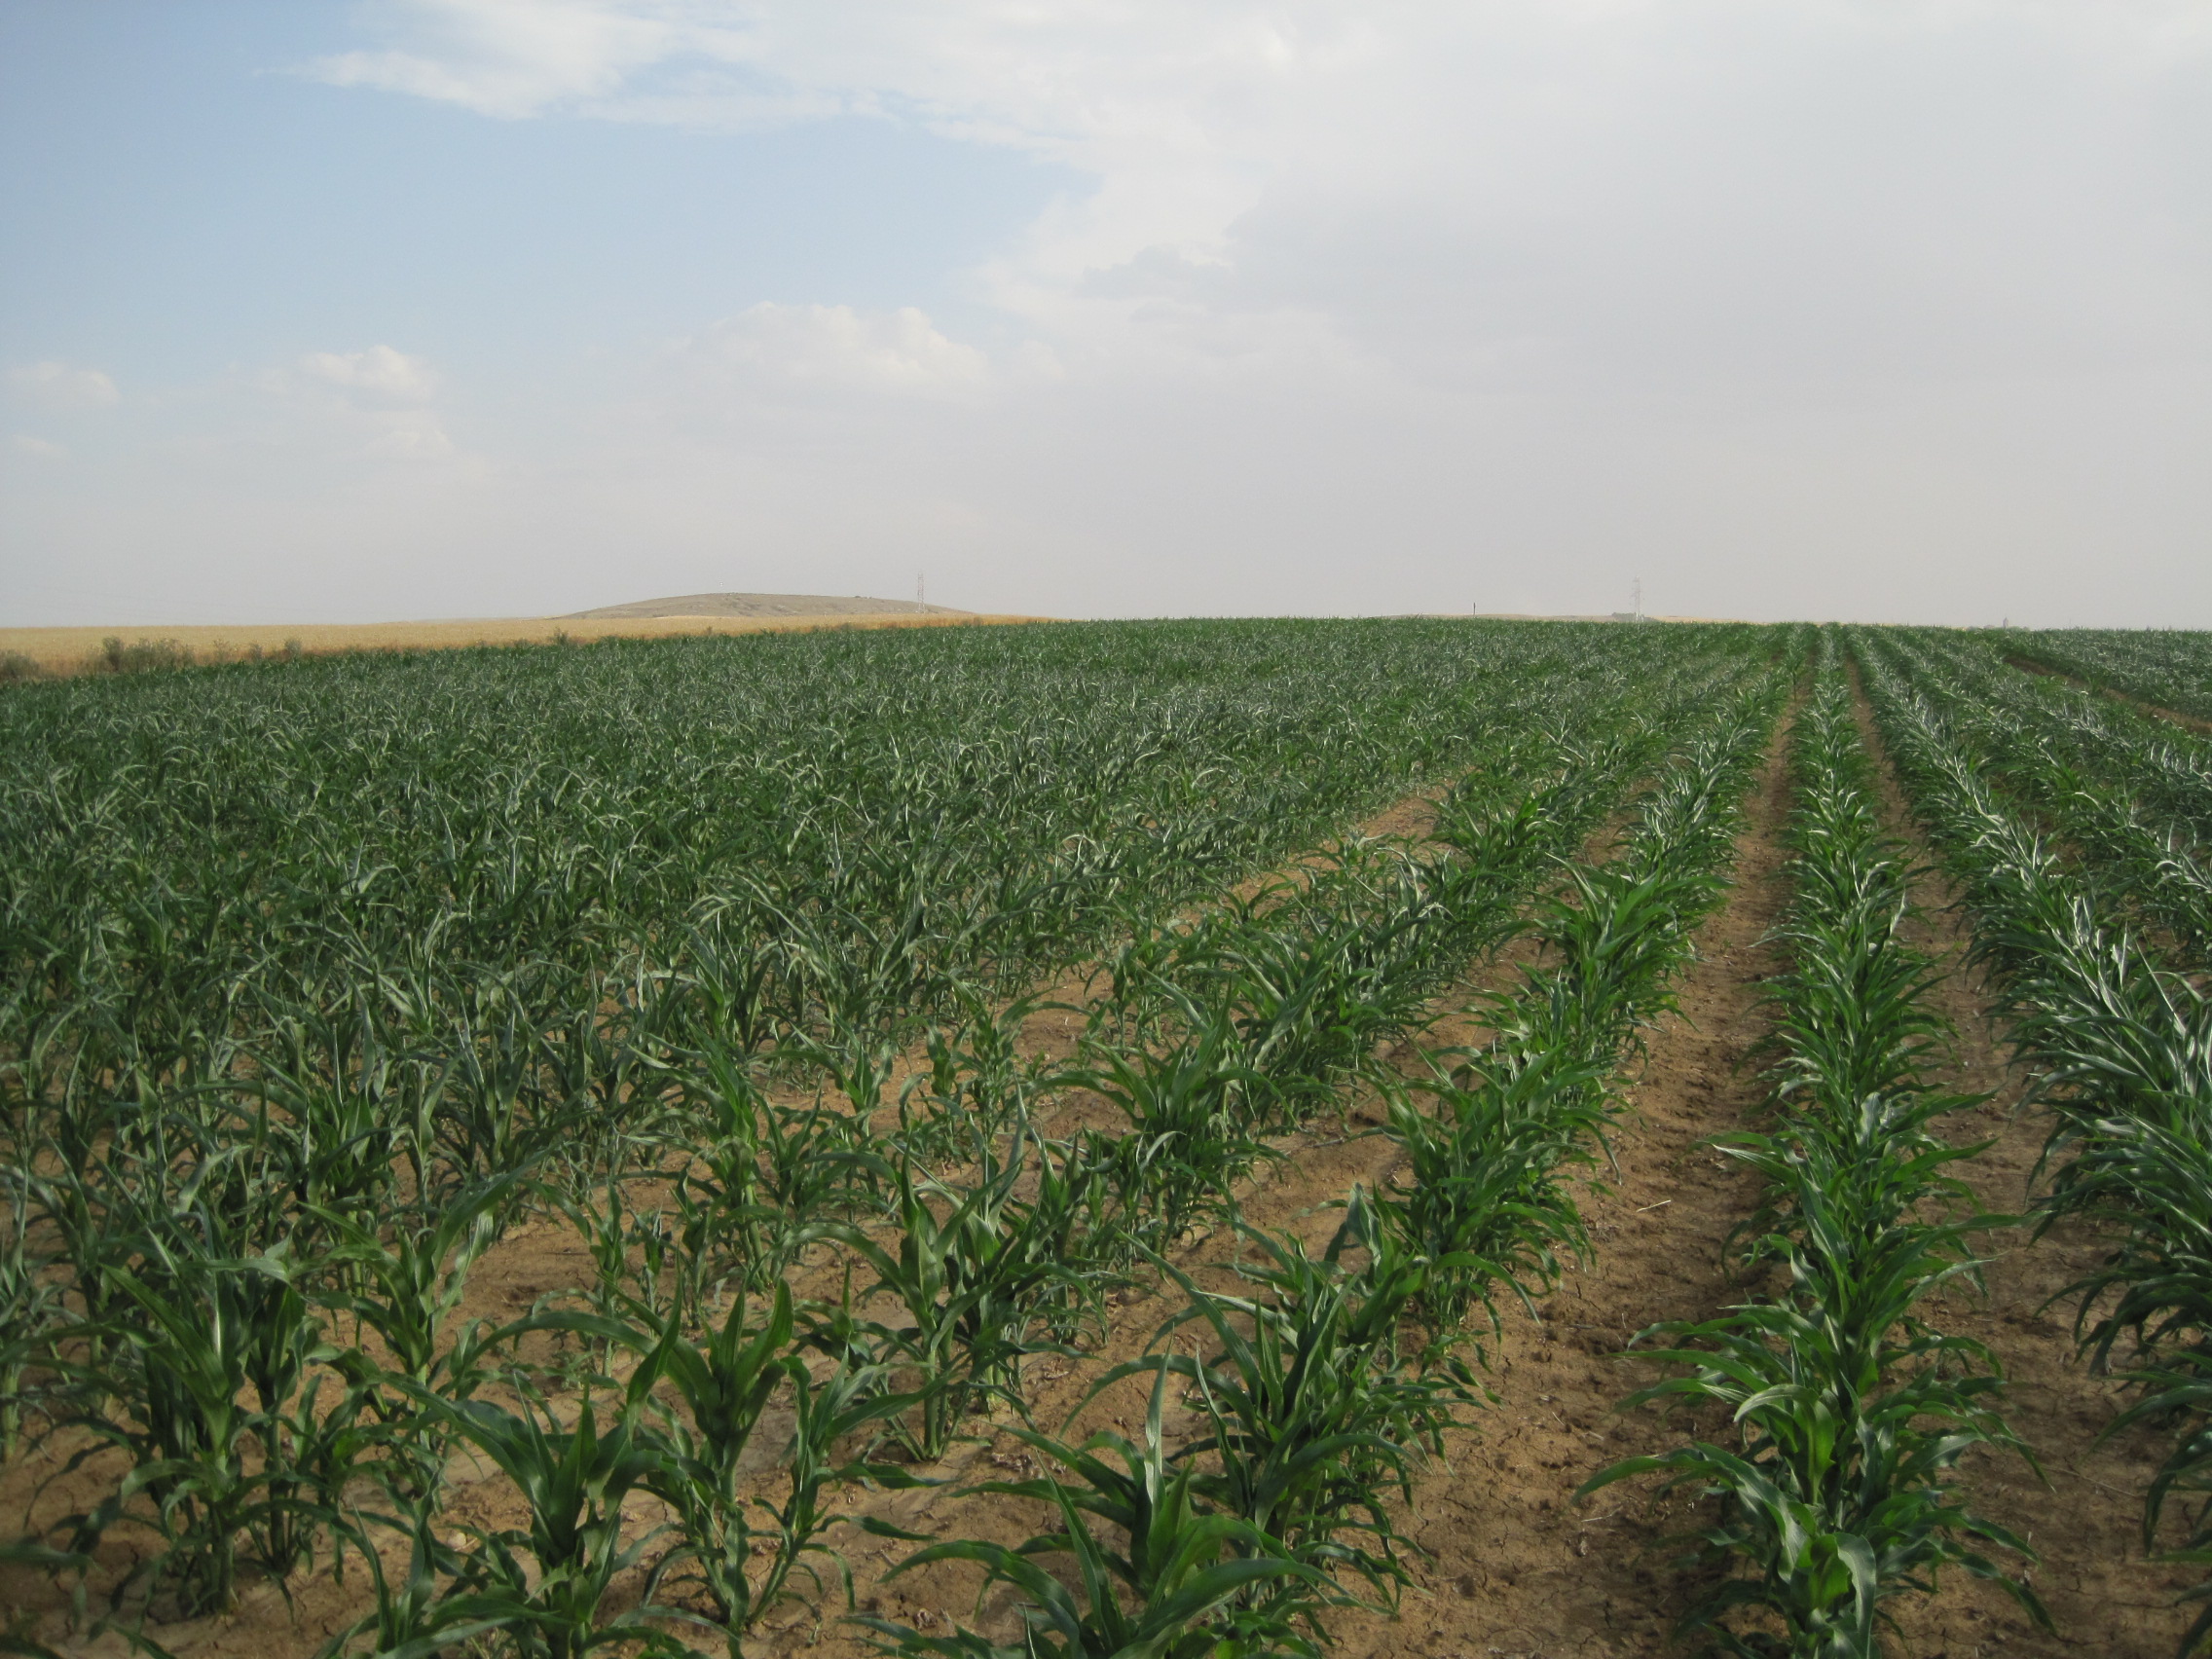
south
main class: Cropland
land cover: Maize
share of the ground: > 75 %
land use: Agriculture (excluding fallow land and kitchen gardens)
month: July
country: ES
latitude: 41.6780
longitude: -5.3487
